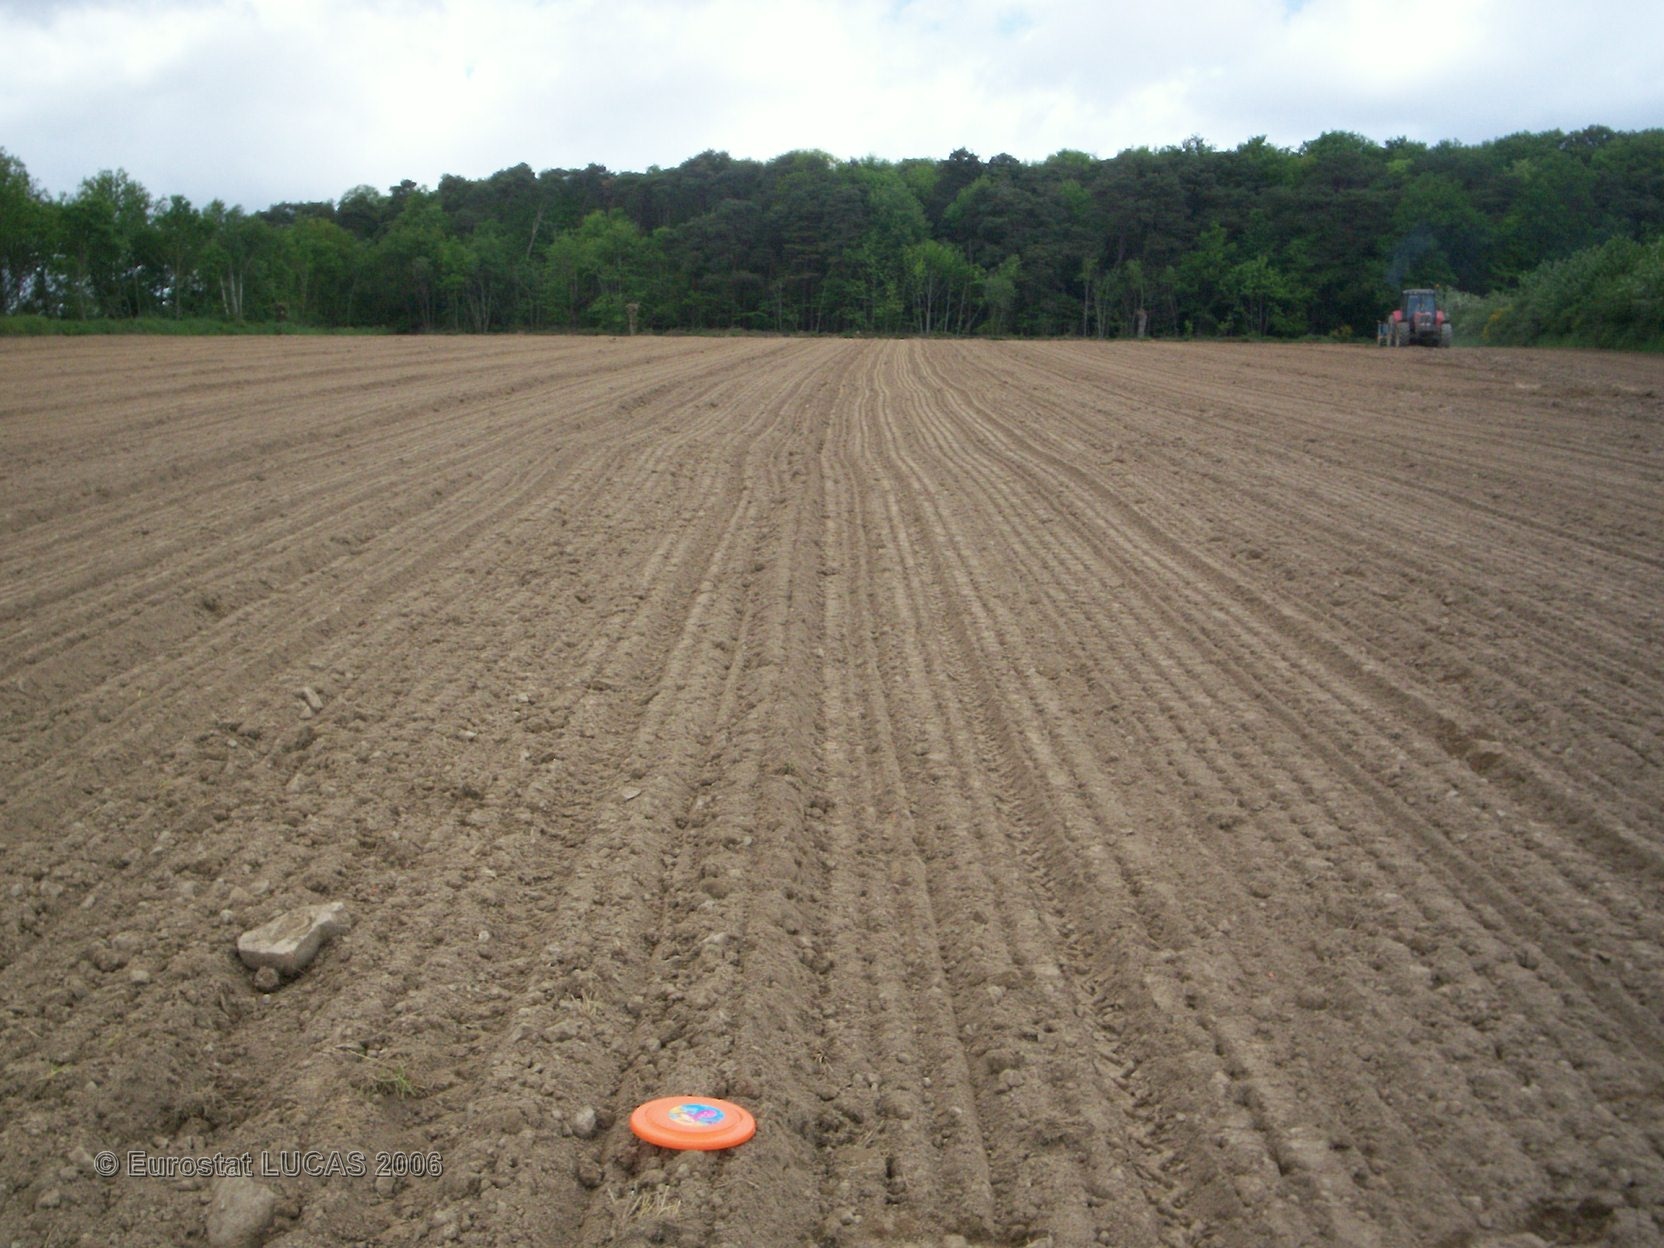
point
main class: Cropland
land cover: Maize
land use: Agriculture (excluding fallow land and kitchen gardens)
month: May
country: FR
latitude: 47.7727
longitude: -1.0744
